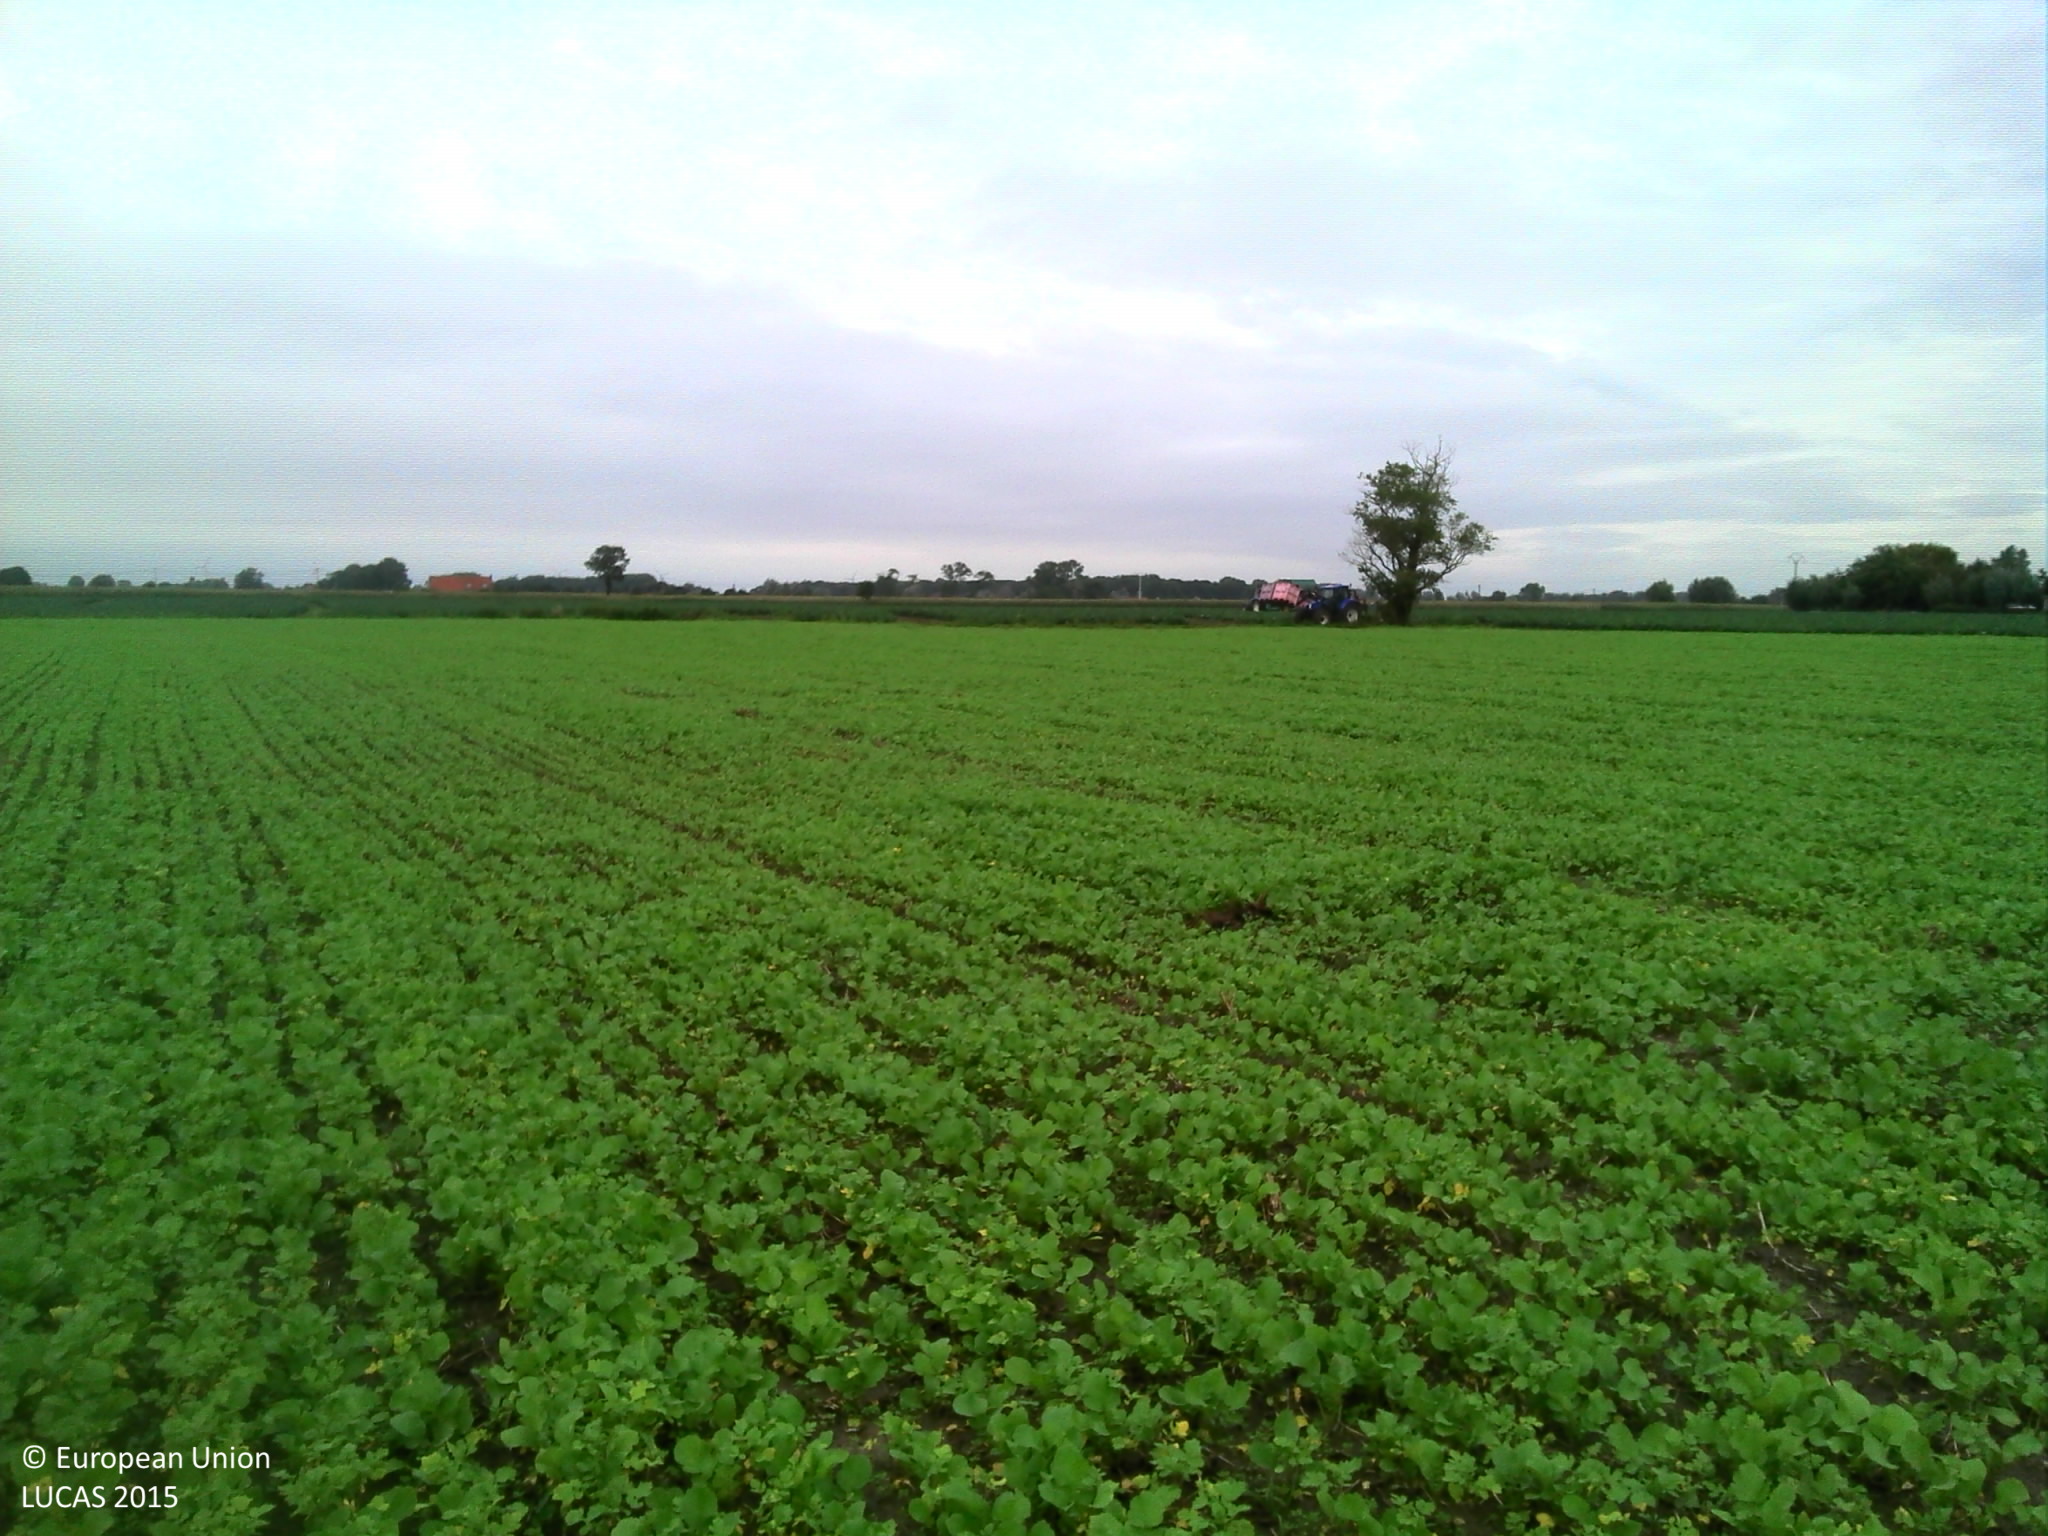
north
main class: Cropland
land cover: Other fibre and oleaginous crops
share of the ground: > 75 %
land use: Agriculture (excluding fallow land and kitchen gardens)
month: September
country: BE
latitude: 51.1047
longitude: 2.9773
